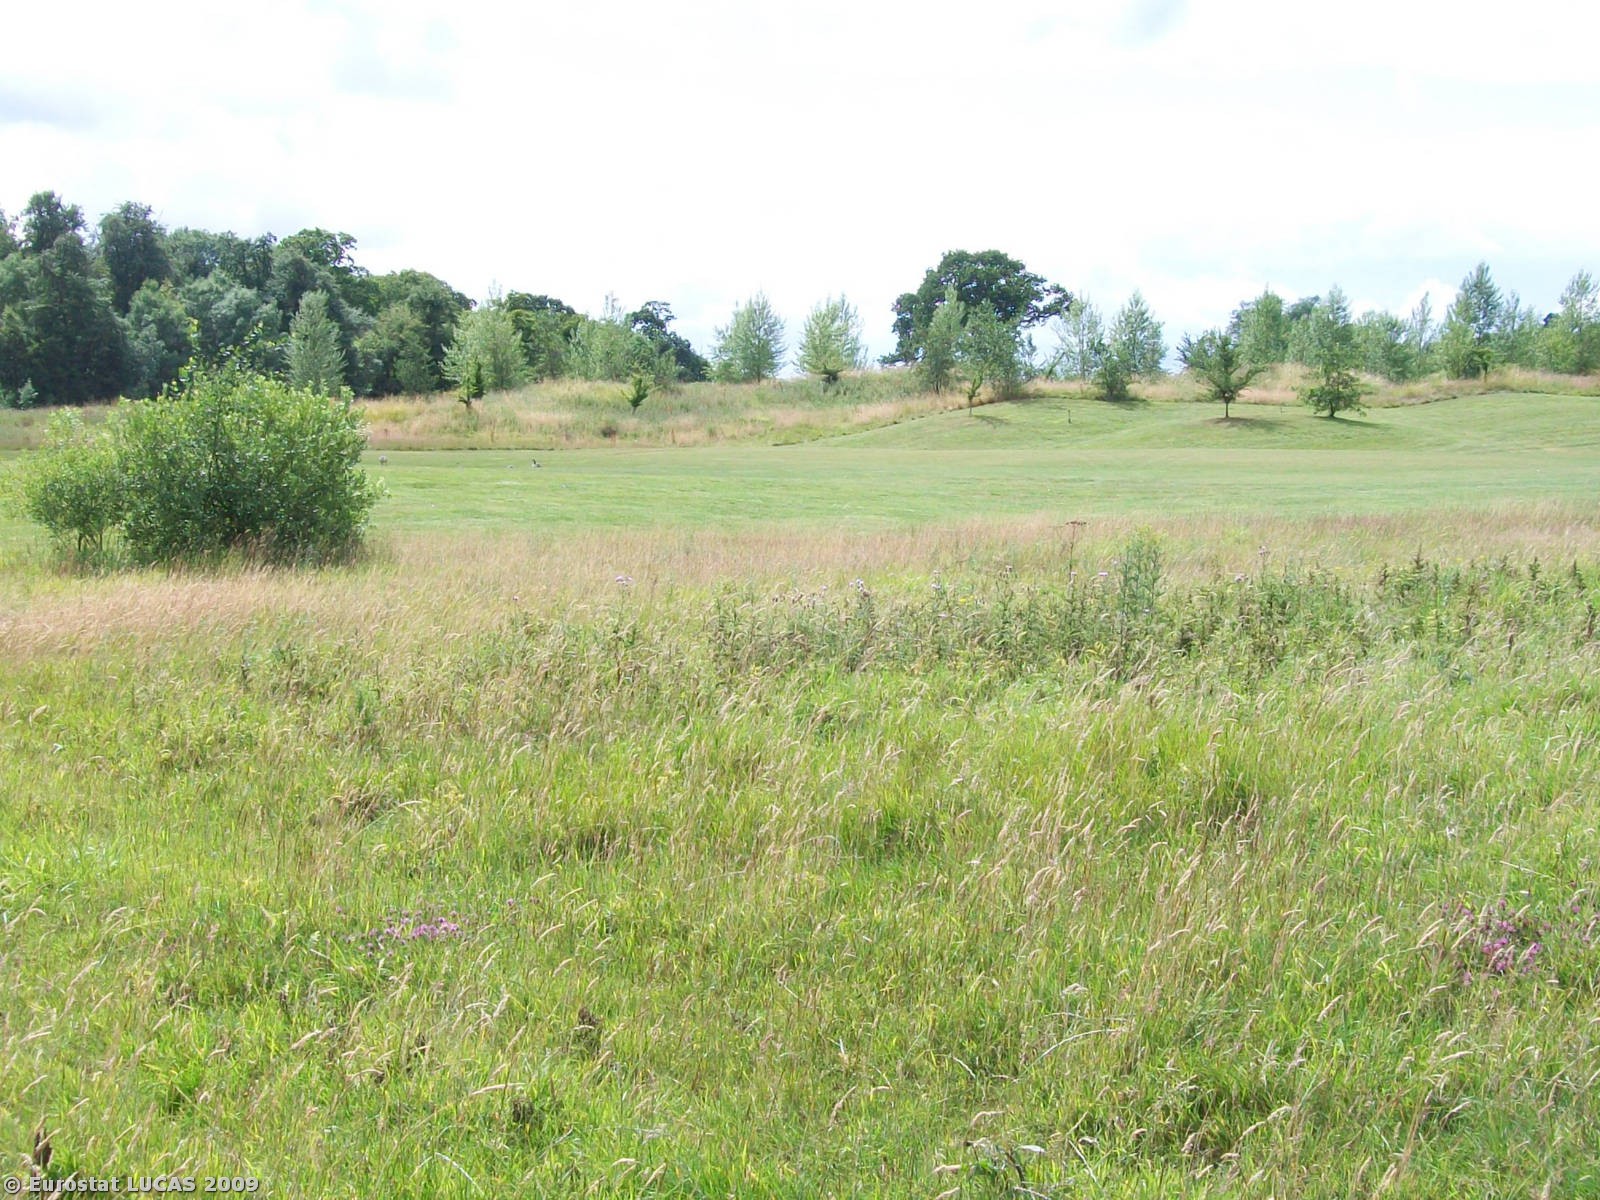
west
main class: Grassland
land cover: Grassland with sparse tree/shrub cover
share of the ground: > 75 %
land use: Sport
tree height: > 5 m
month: July
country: GB
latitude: 51.3752
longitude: -2.2594
